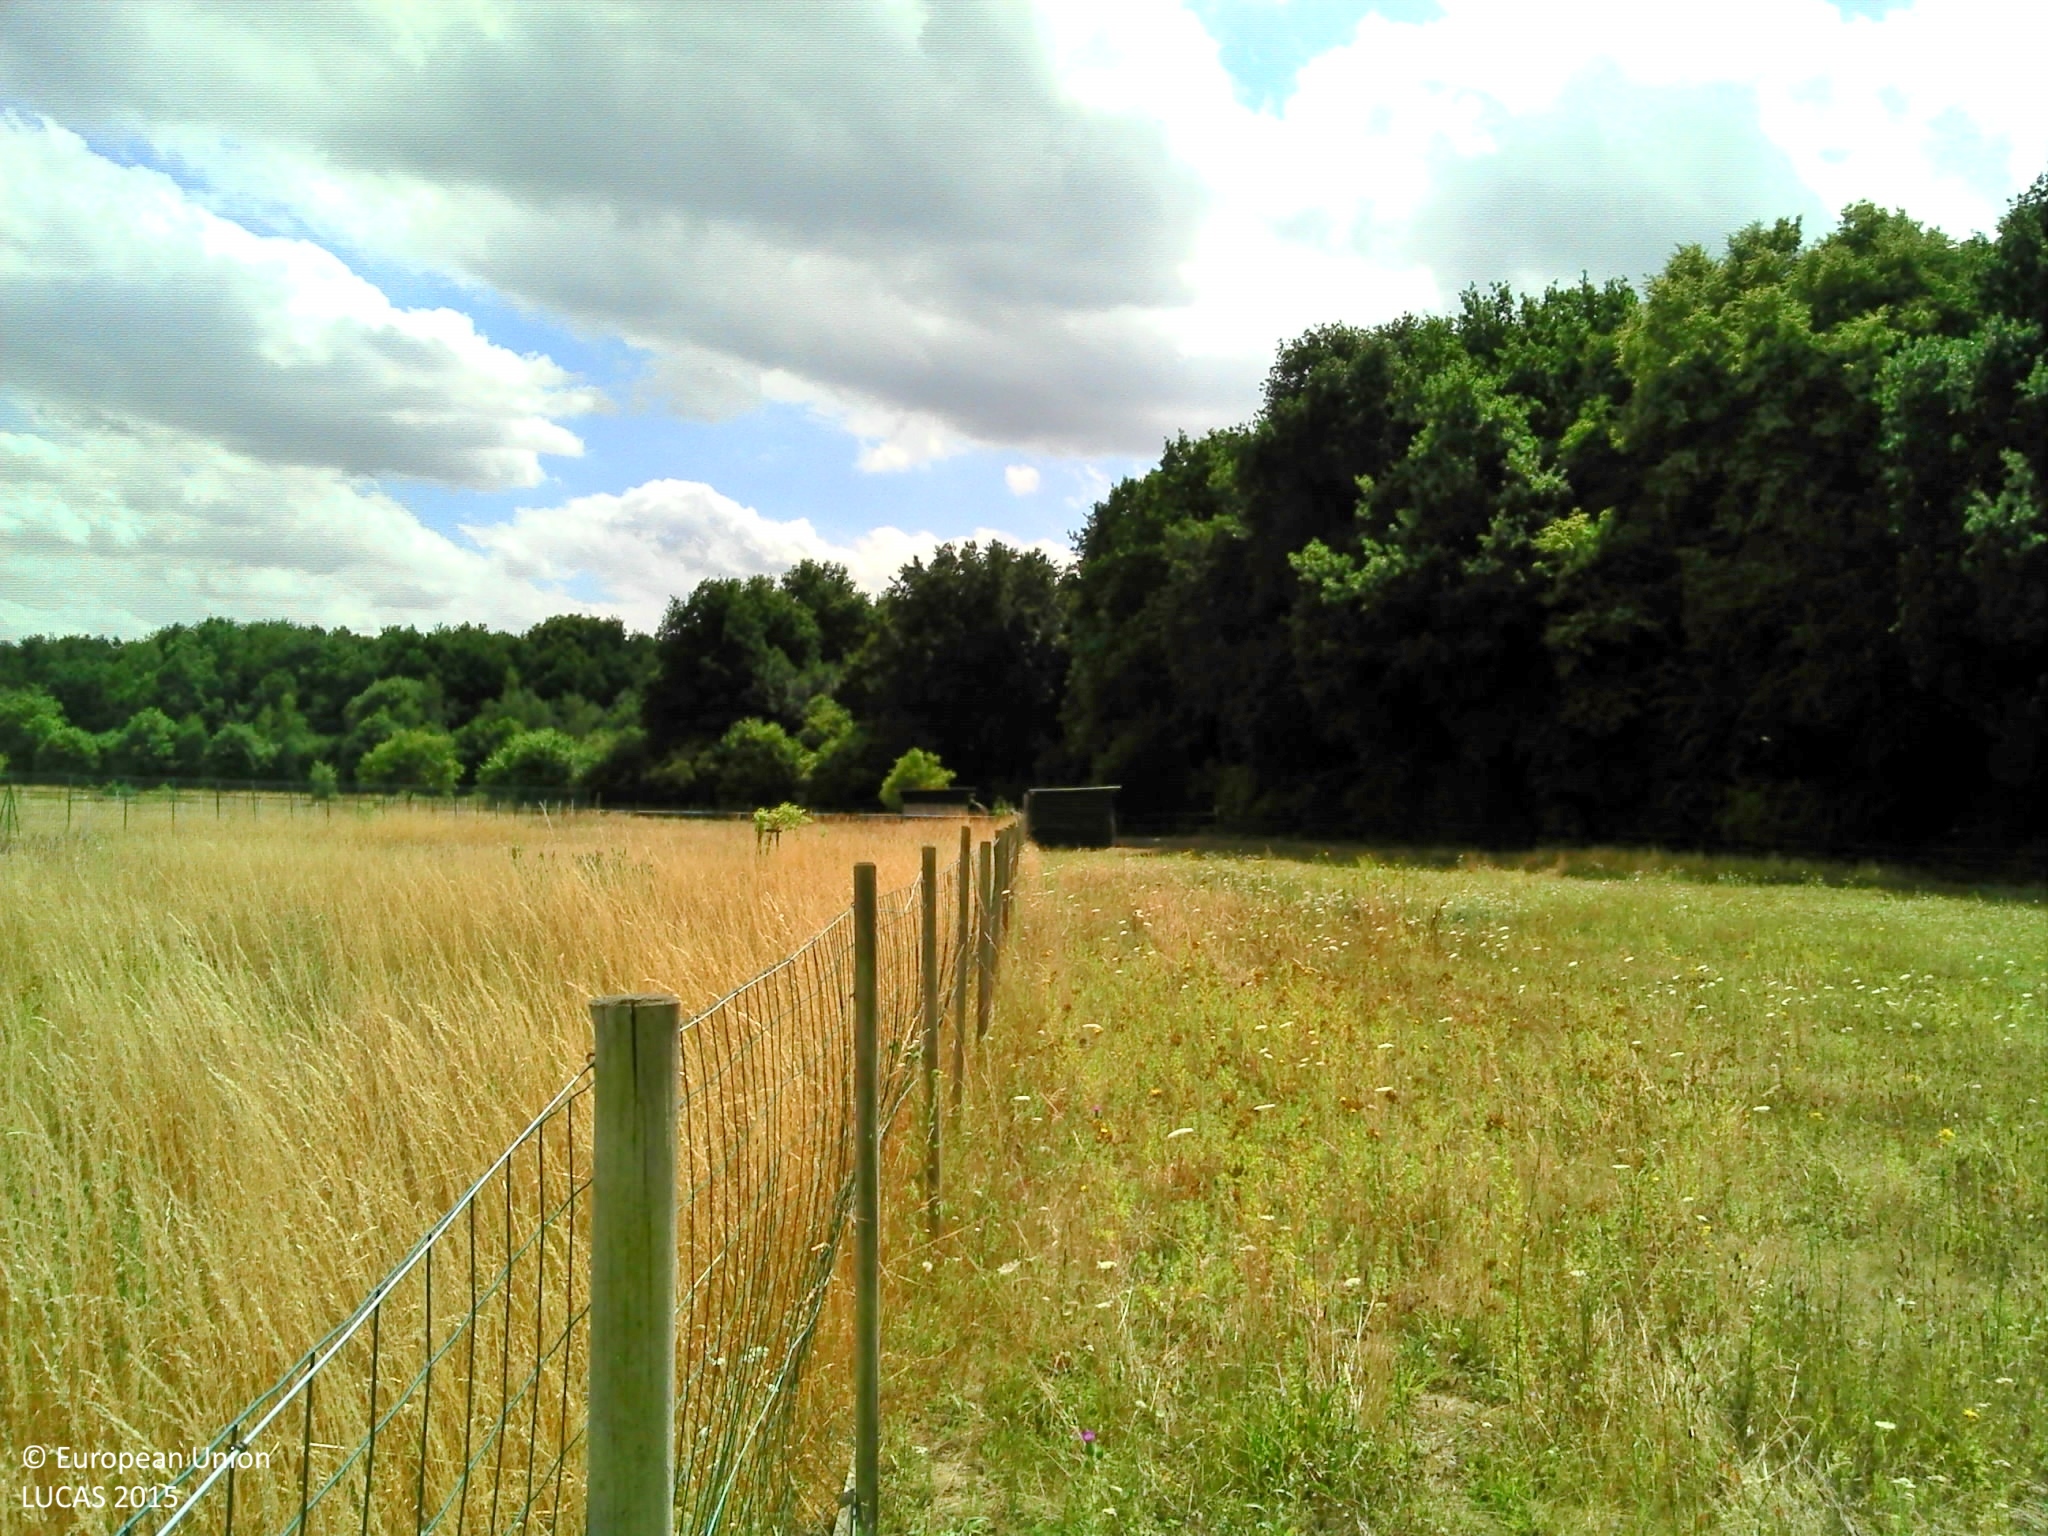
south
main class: Grassland
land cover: Grassland without tree/shrub cover
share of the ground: > 75 %
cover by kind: herbaceous plants 100 %
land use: Agriculture (excluding fallow land and kitchen gardens)
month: July
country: FR
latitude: 49.1471
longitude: 2.5720
